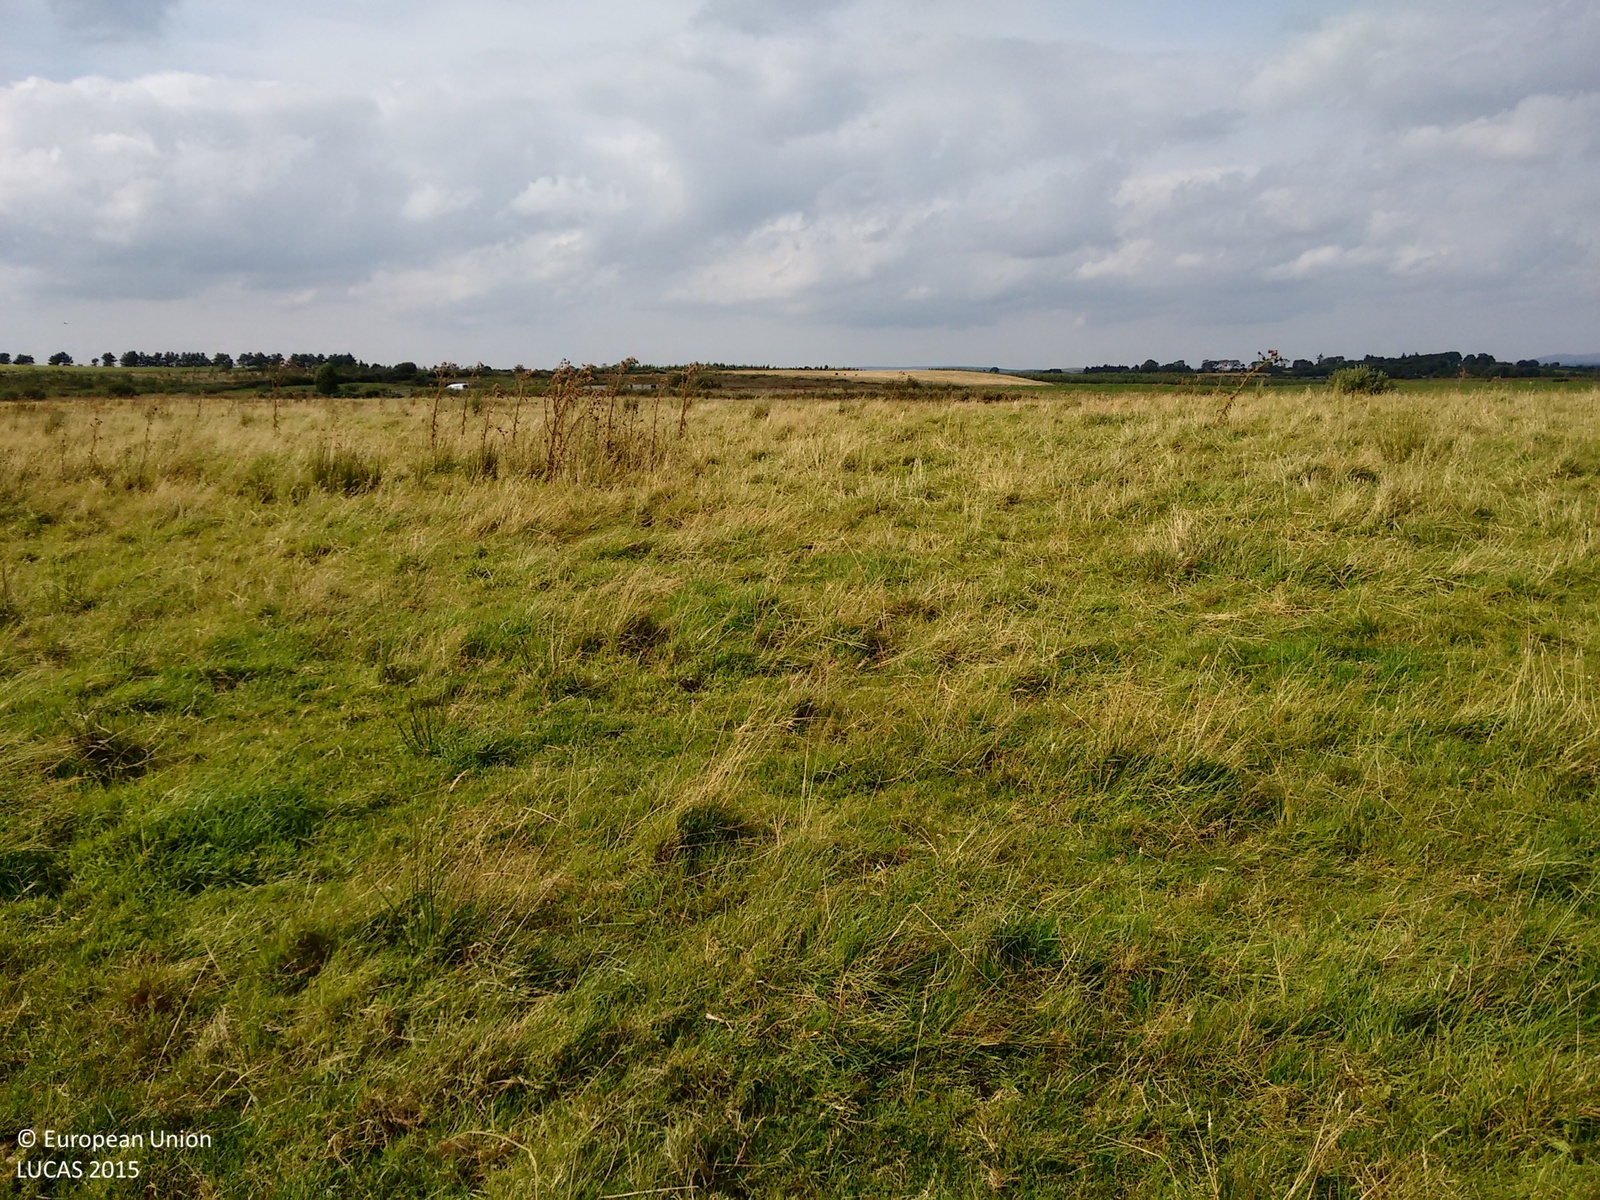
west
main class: Grassland
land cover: Grassland without tree/shrub cover
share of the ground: > 75 %
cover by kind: herbaceous plants 100 %
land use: Agriculture (excluding fallow land and kitchen gardens)
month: September
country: IE
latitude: 54.1097
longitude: -9.3929
